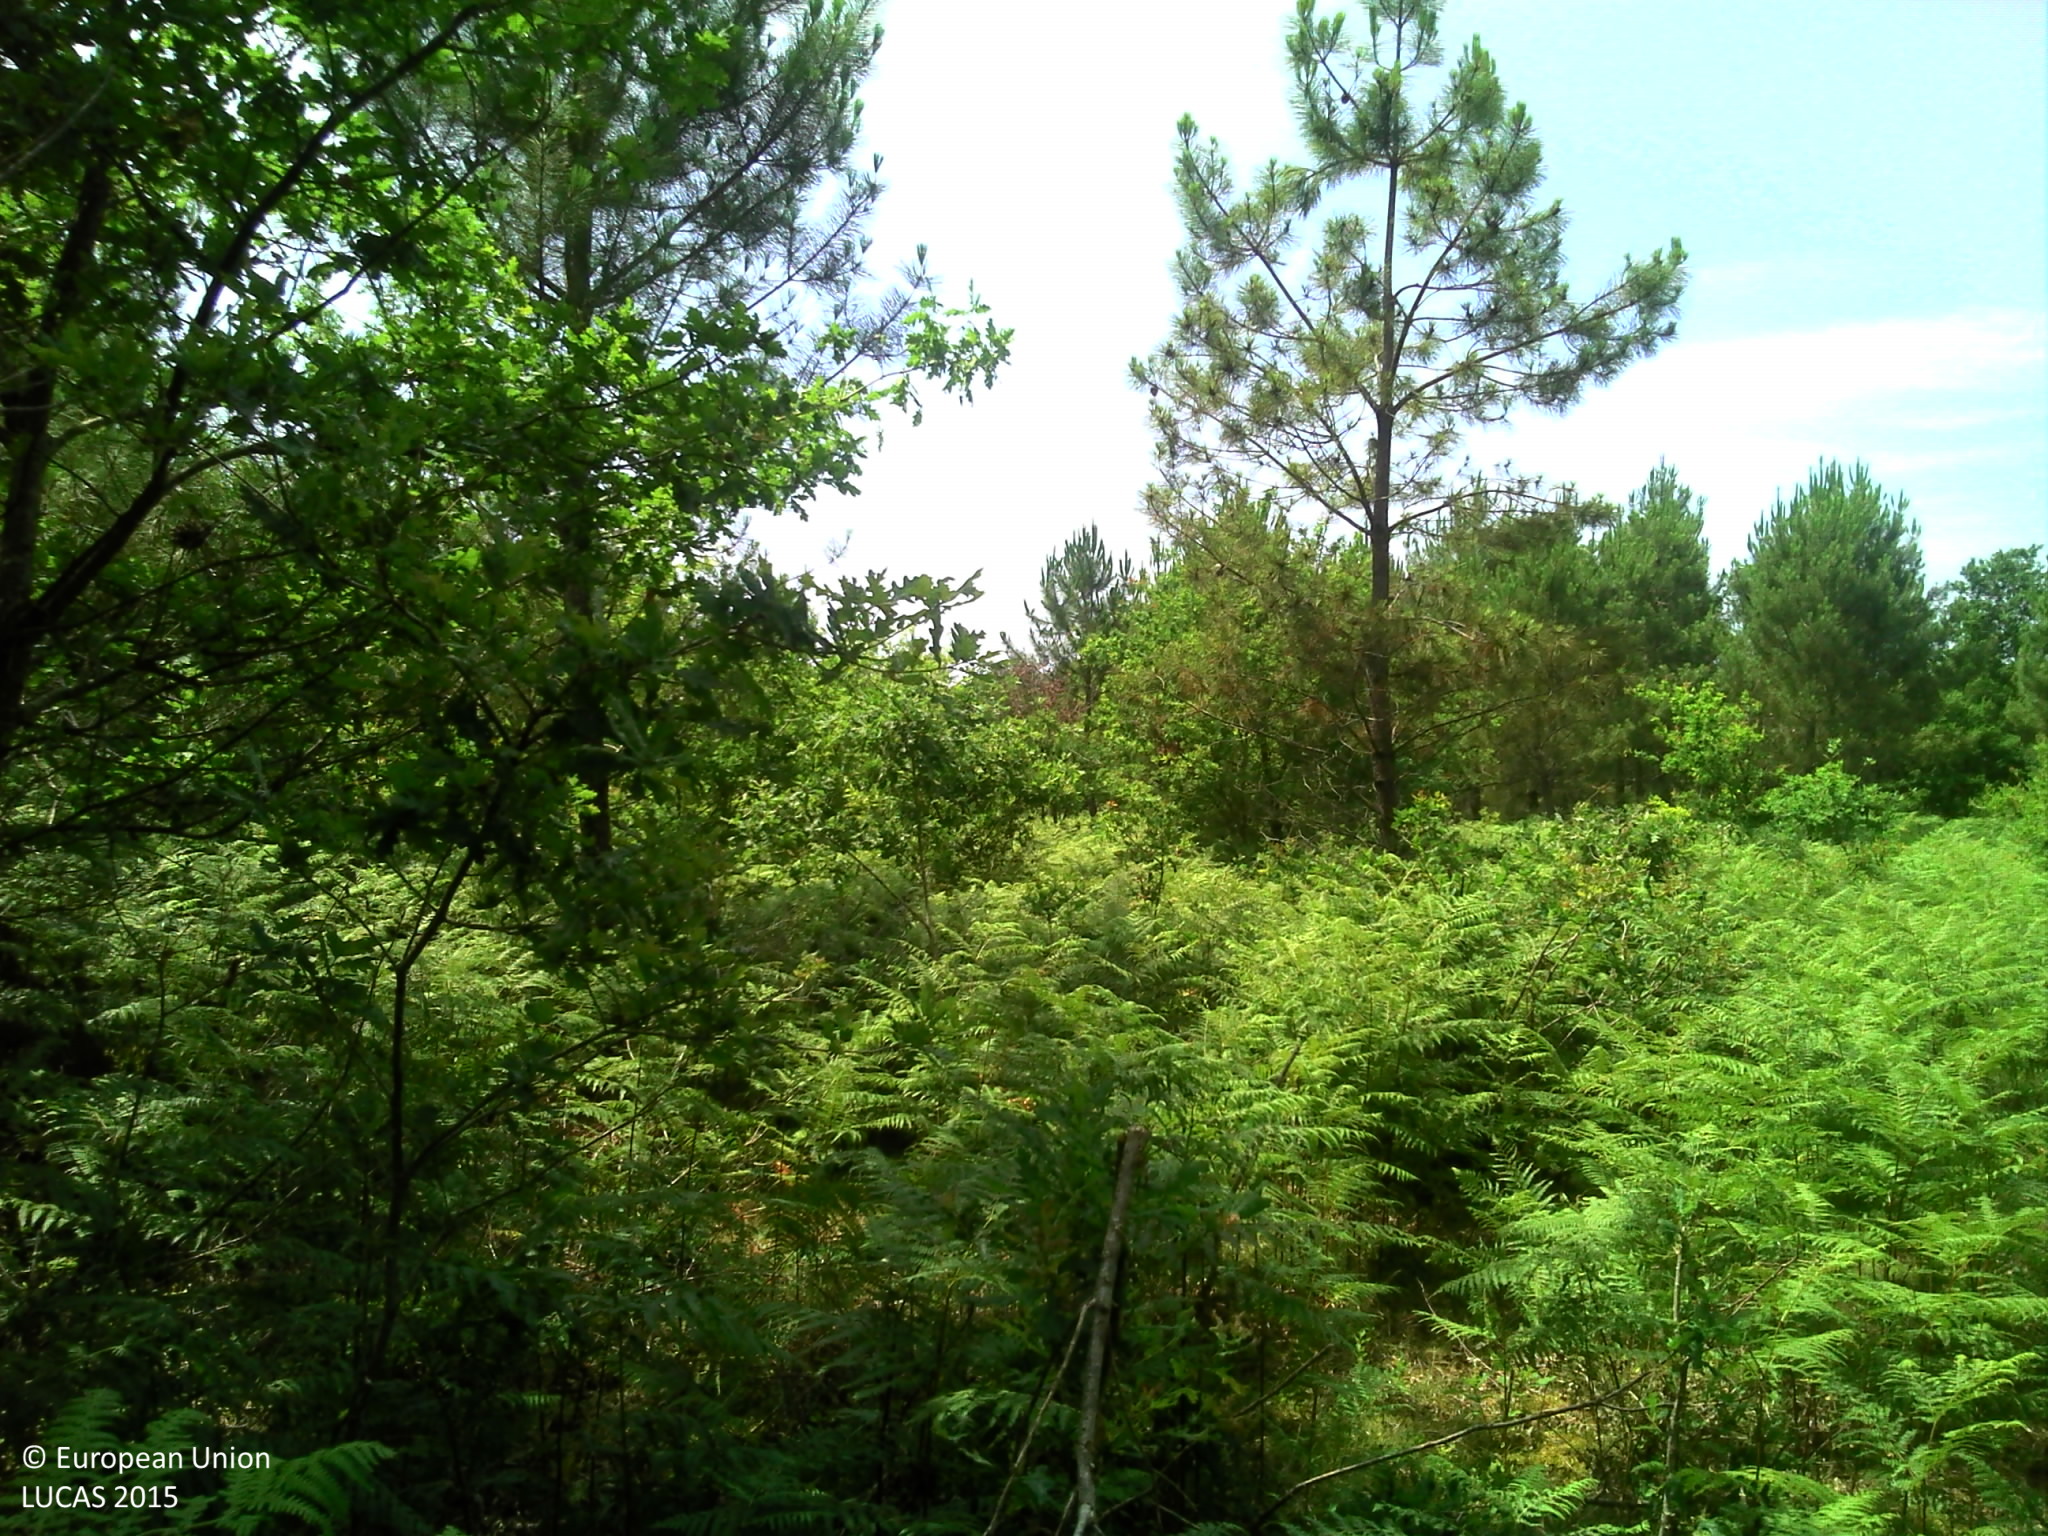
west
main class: Woodland
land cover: Pine dominated mixed woodland
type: coniferous forest of the mediterranean region
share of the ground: > 75 %
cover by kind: herbaceous plants 40 %, coniferous forest trees 30 %, broadleaved forest trees 25 %, shrubs 5 %
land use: Forestry
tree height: < 5 m
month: July
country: FR
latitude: 43.8539
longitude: -1.1770
